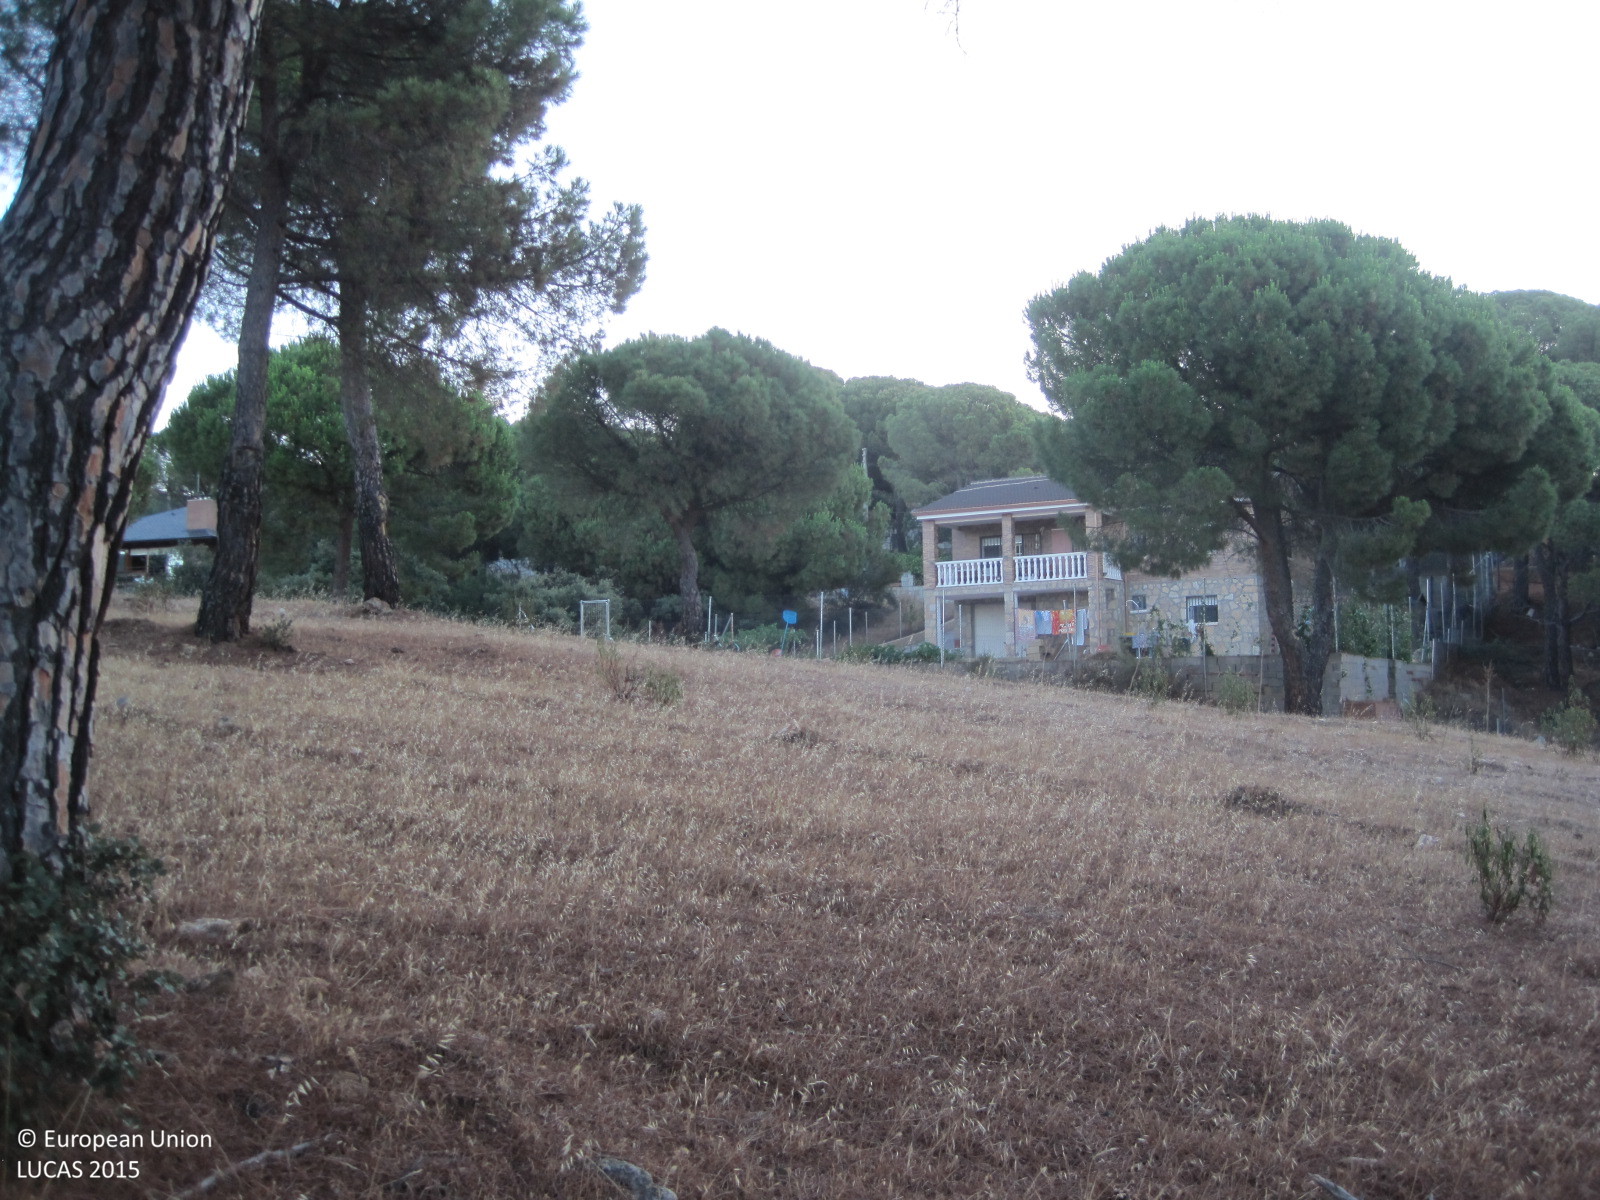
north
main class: Woodland
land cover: Pine dominated coniferous woodland
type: coniferous forest of the mediterranean region
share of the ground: 25 - 50 %
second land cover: Shrubland without tree cover
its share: 25 - 50 %
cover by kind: coniferous forest trees 45 %, herbaceous plants 30 %, shrubs 25 %
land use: Forestry
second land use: Agriculture (excluding fallow land and kitchen gardens)
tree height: > 5 m
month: July
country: ES
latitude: 40.2692
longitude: -4.3562
